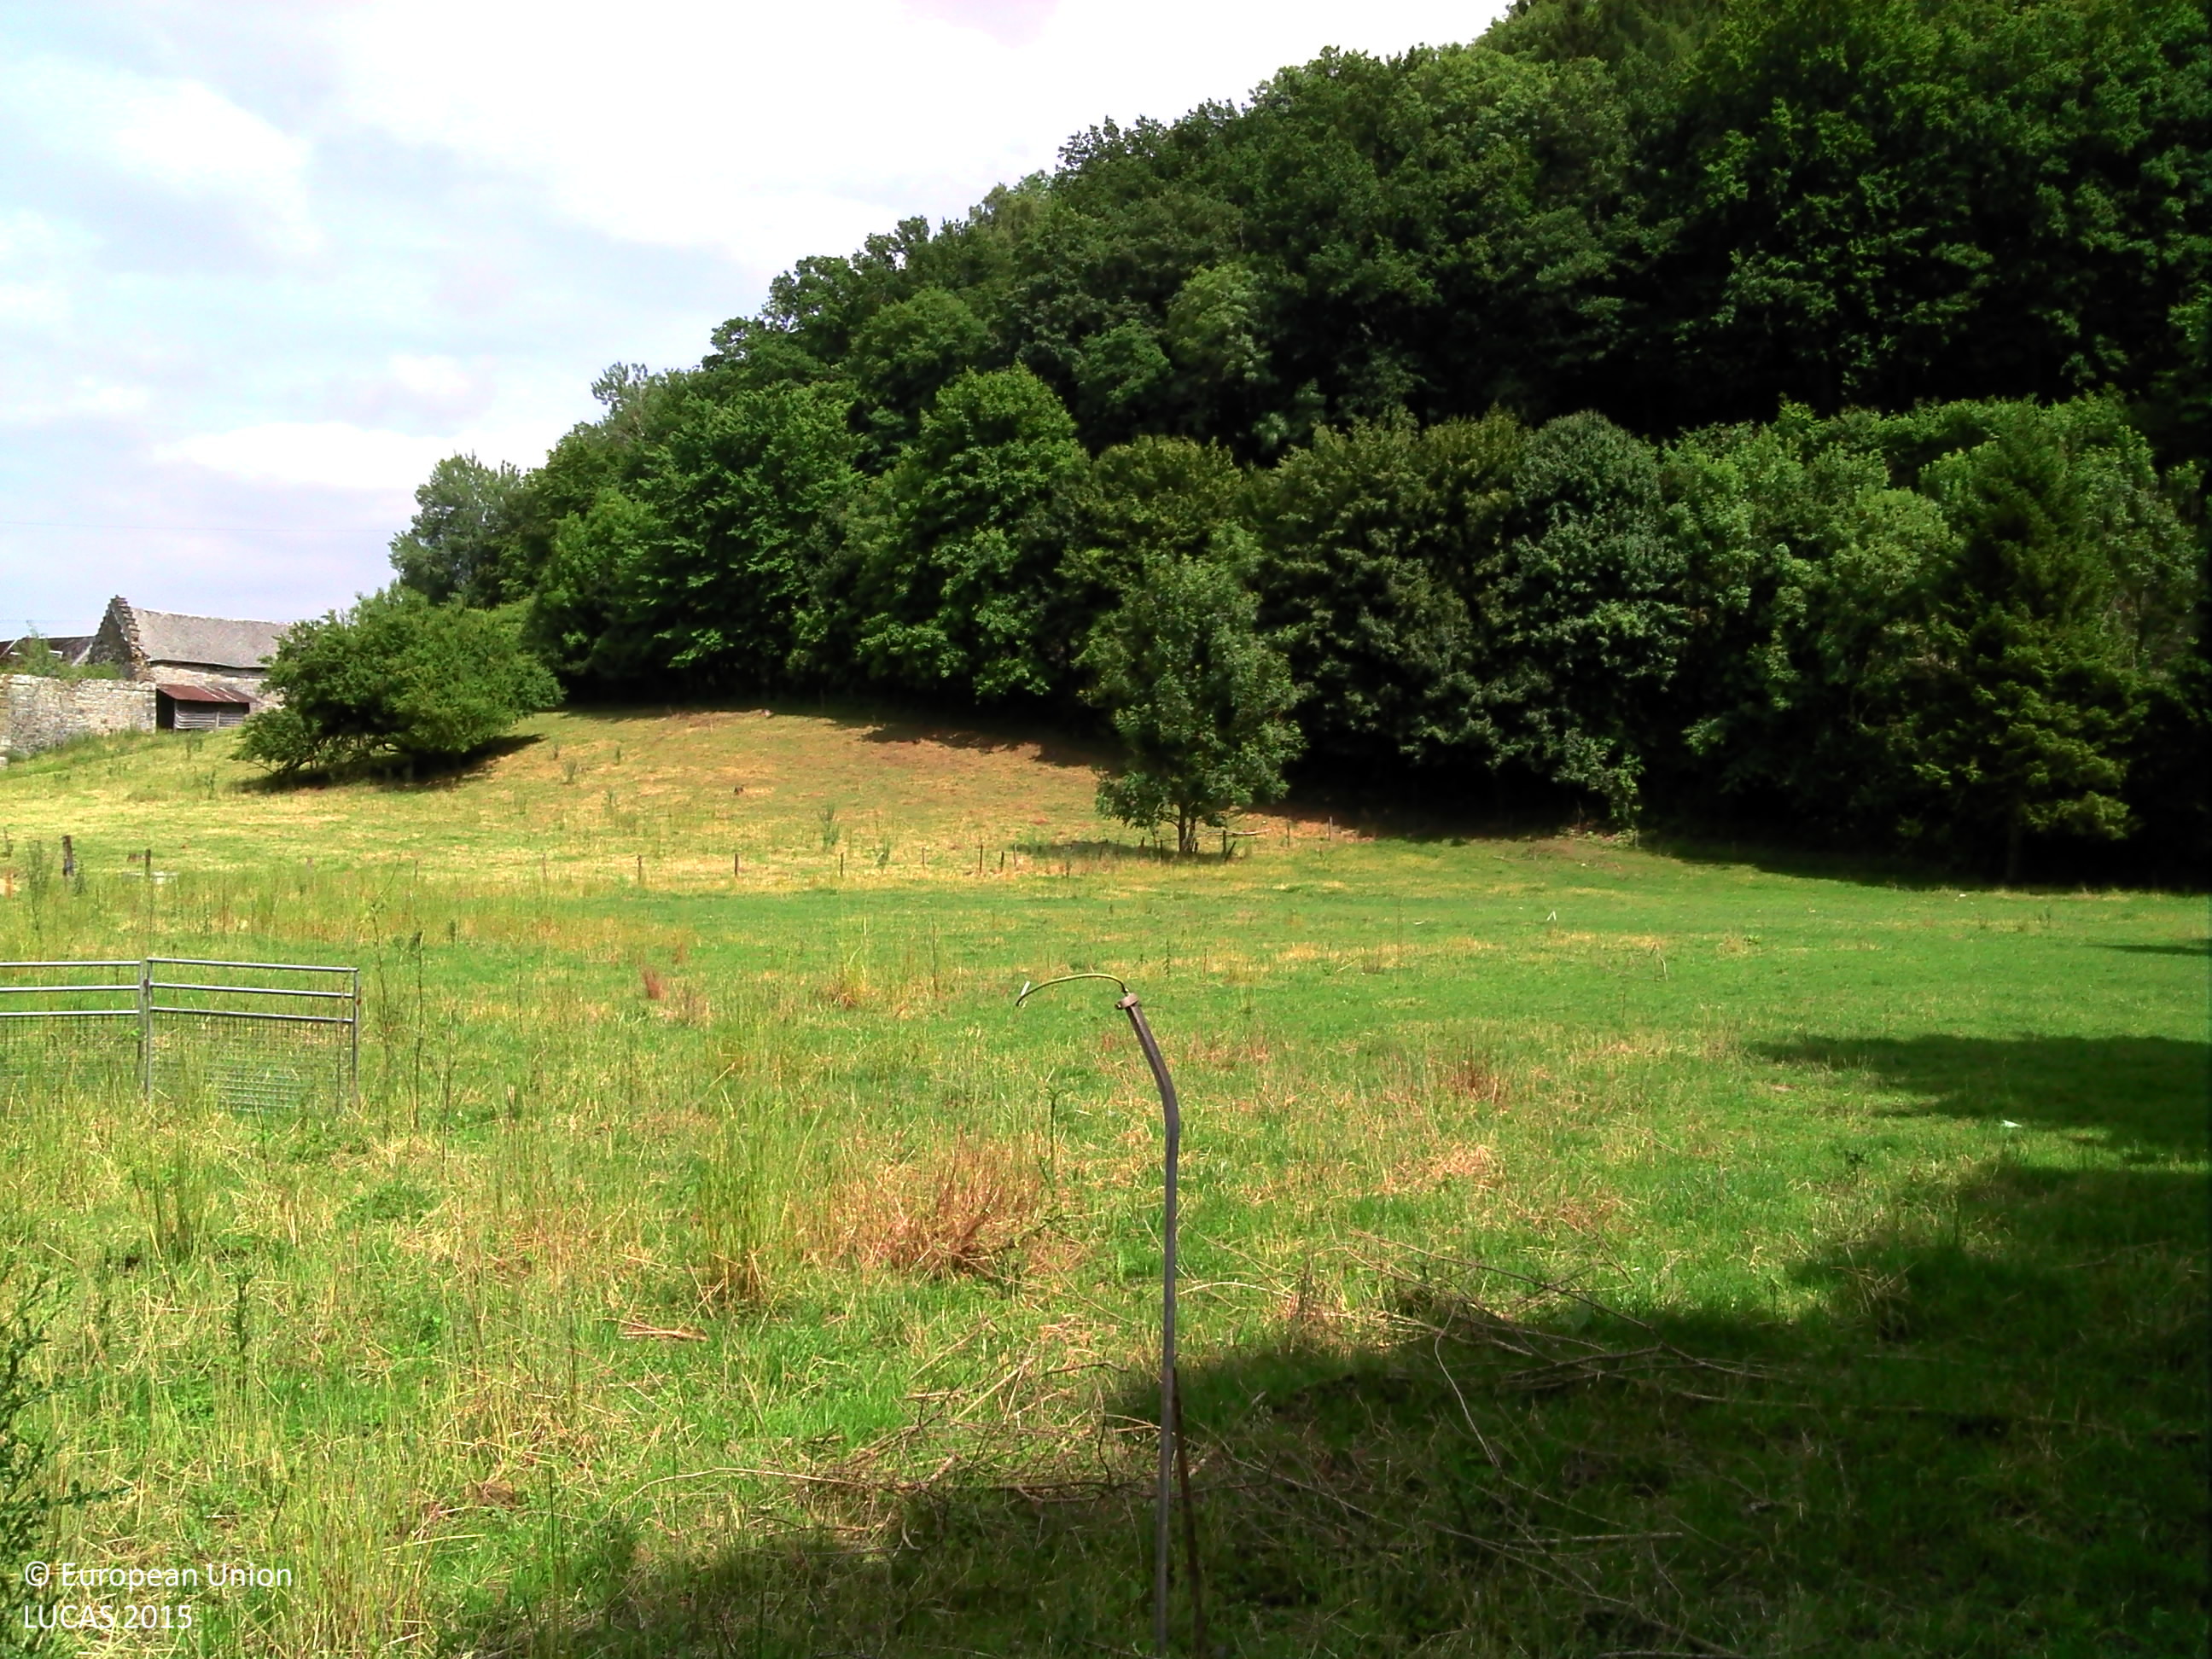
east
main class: Grassland
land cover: Grassland with sparse tree/shrub cover
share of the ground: > 75 %
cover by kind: herbaceous plants 95 %, coniferous forest trees 5 %
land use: Residential
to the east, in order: Grassland with sparse tree/shrub cover; Fences; Grassland without tree/shrub cover; Fences; Broadleaved woodland; Railways; Rock outcrops; Managed hedges; Fences; Paved roads, cycling and walking lanes; Broadleaved woodland
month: June
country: BE
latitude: 50.4390
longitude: 5.5349
